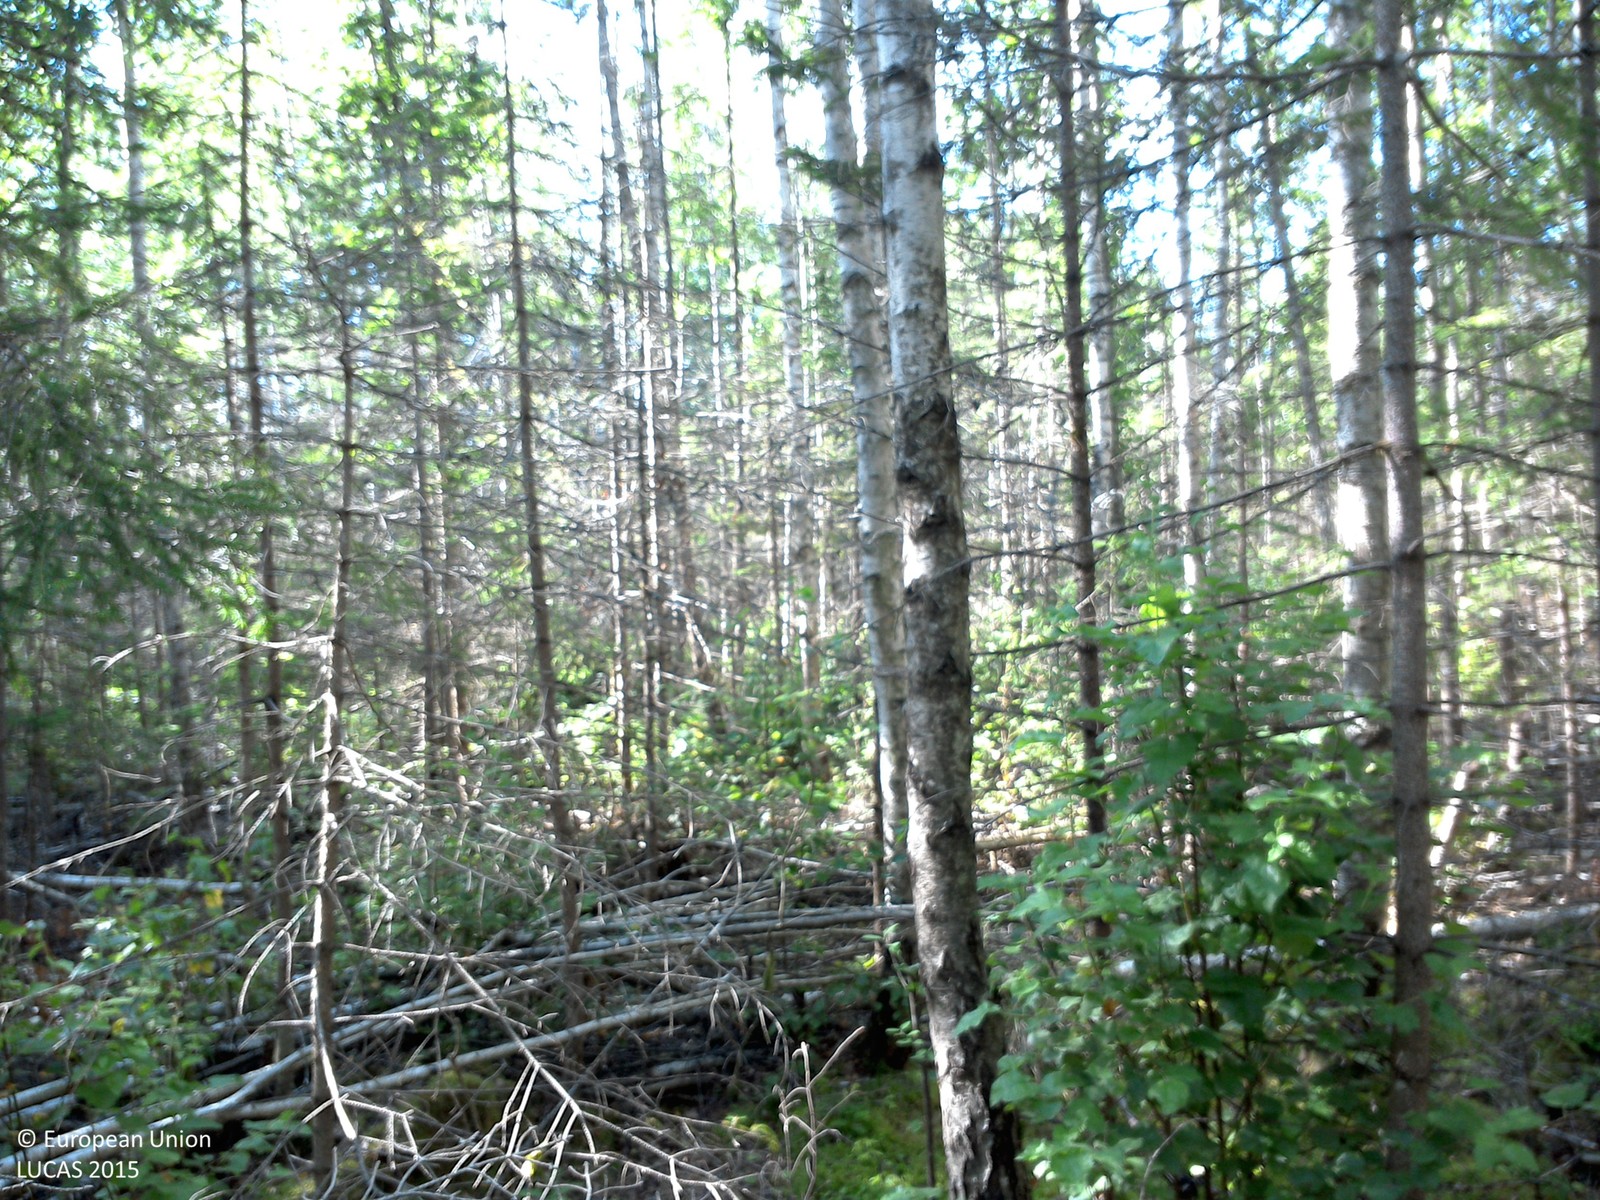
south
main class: Woodland
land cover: Broadleaved woodland
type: hemiboreal forest and nemoral coniferous forest and mixed broadleaved-coniferous forest
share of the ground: 50 - 75 %
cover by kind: broadleaved forest trees 65 %, herbaceous plants 25 %, lichens and mosses 10 %
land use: Forestry
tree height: > 5 m
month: July
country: SE
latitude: 58.2788
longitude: 15.2636
